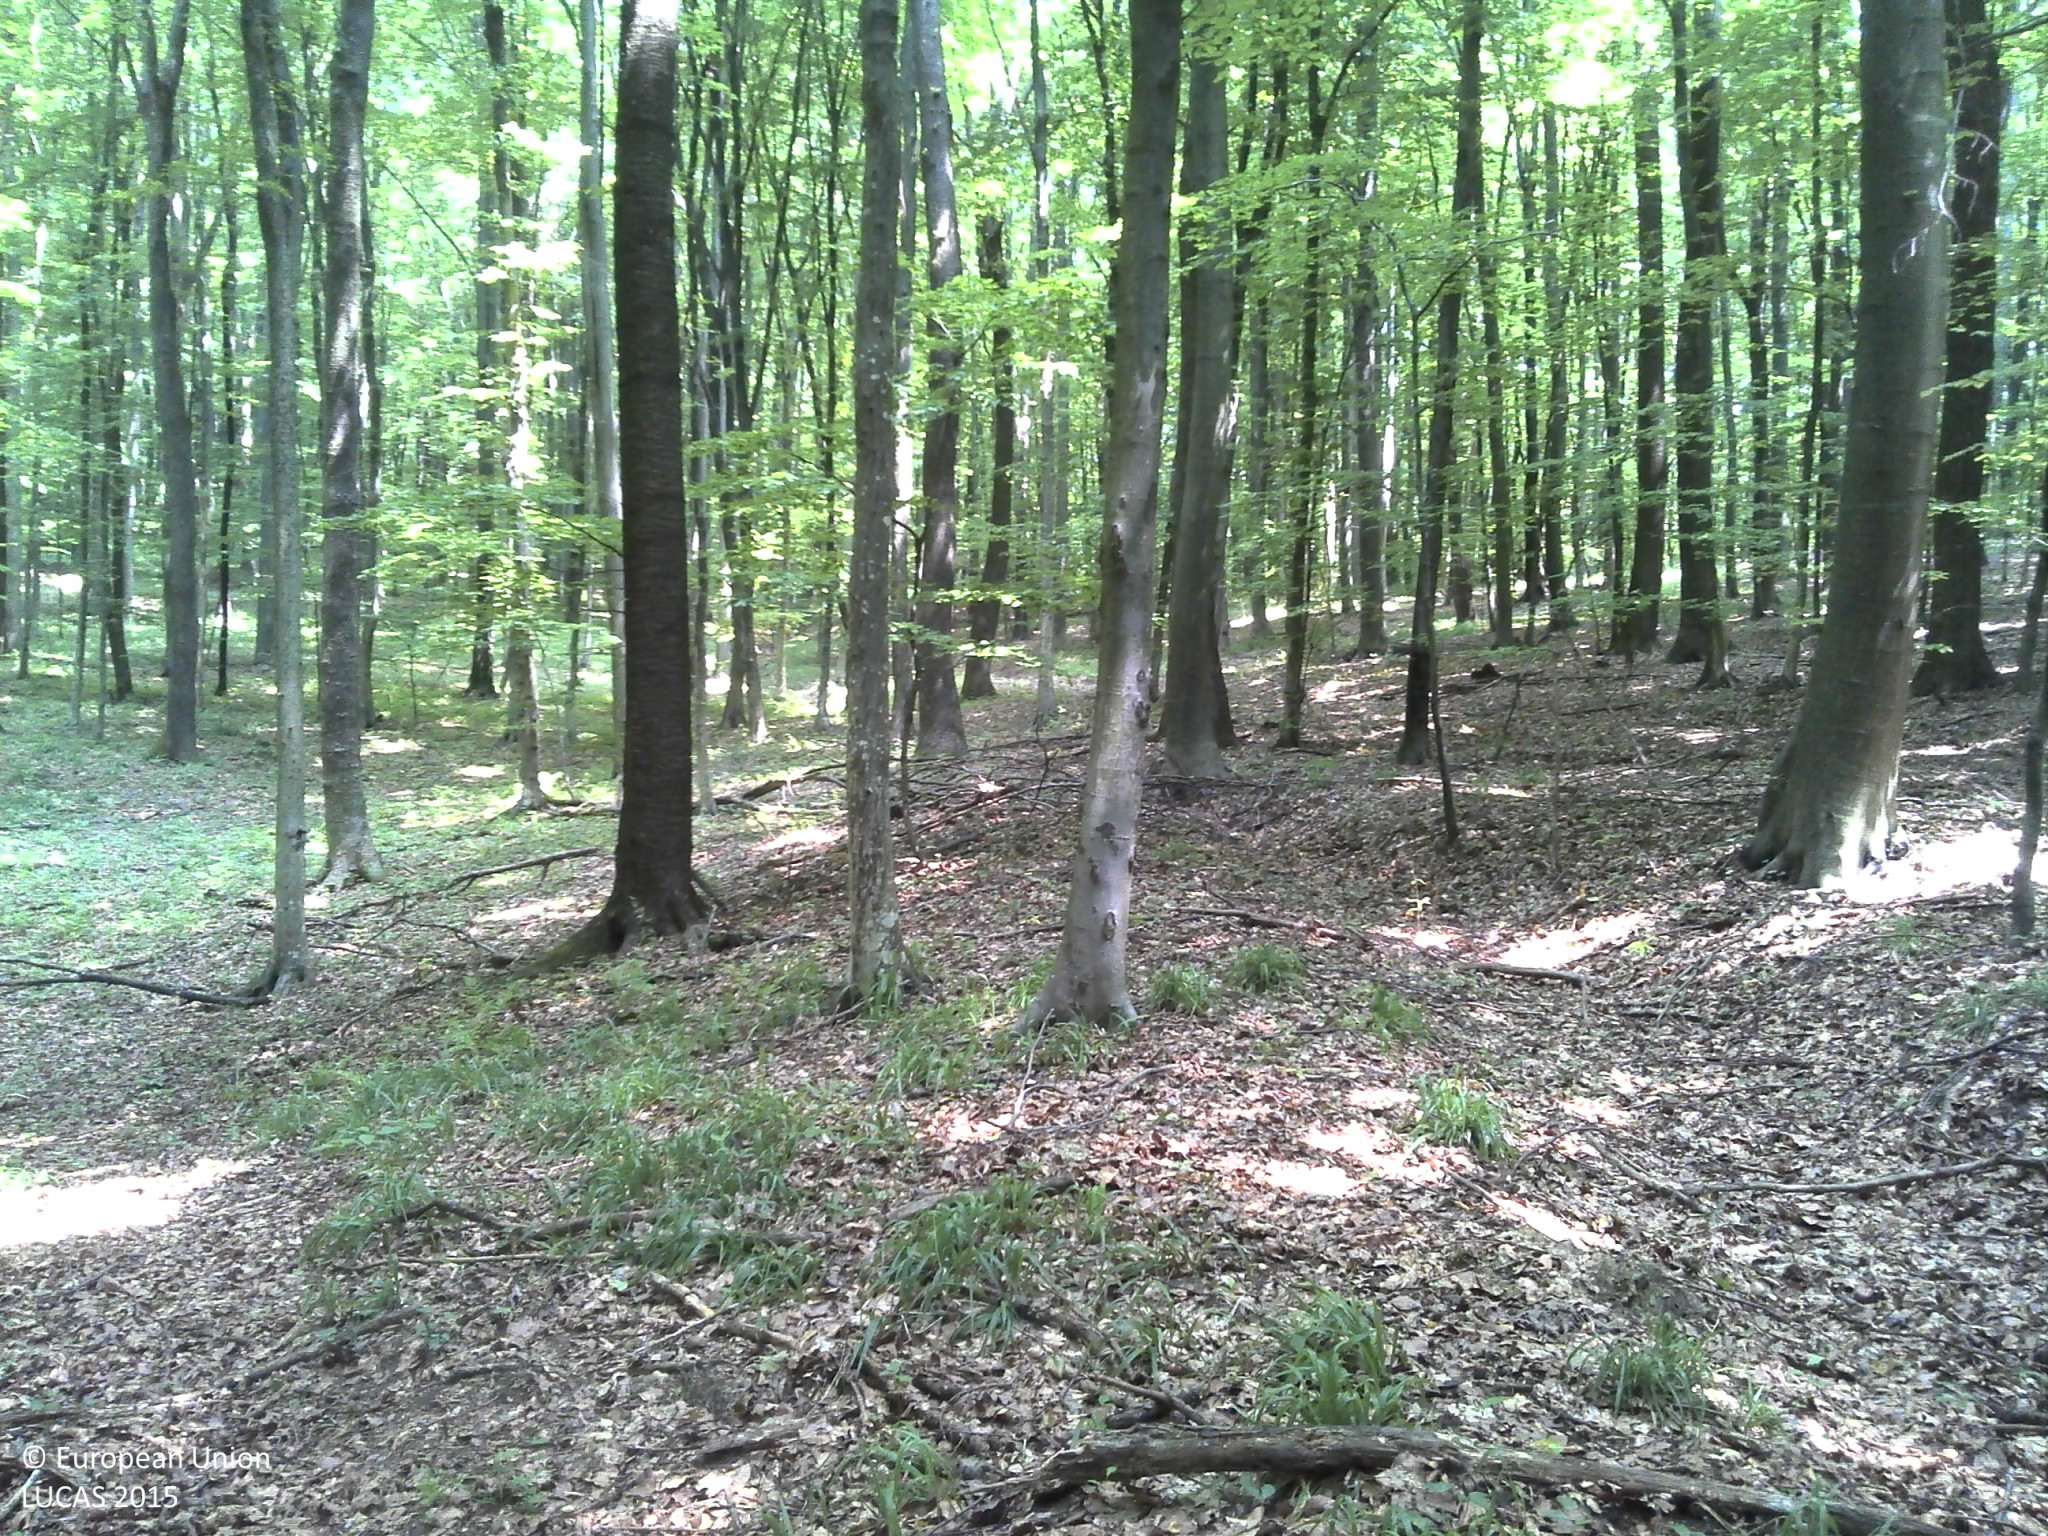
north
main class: Woodland
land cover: Broadleaved woodland
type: acidophilous oak and oak-birch forest
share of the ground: > 75 %
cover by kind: broadleaved forest trees 95 %, herbaceous plants 5 %
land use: Forestry
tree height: > 5 m
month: July
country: HR
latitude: 46.0762
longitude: 16.8670
